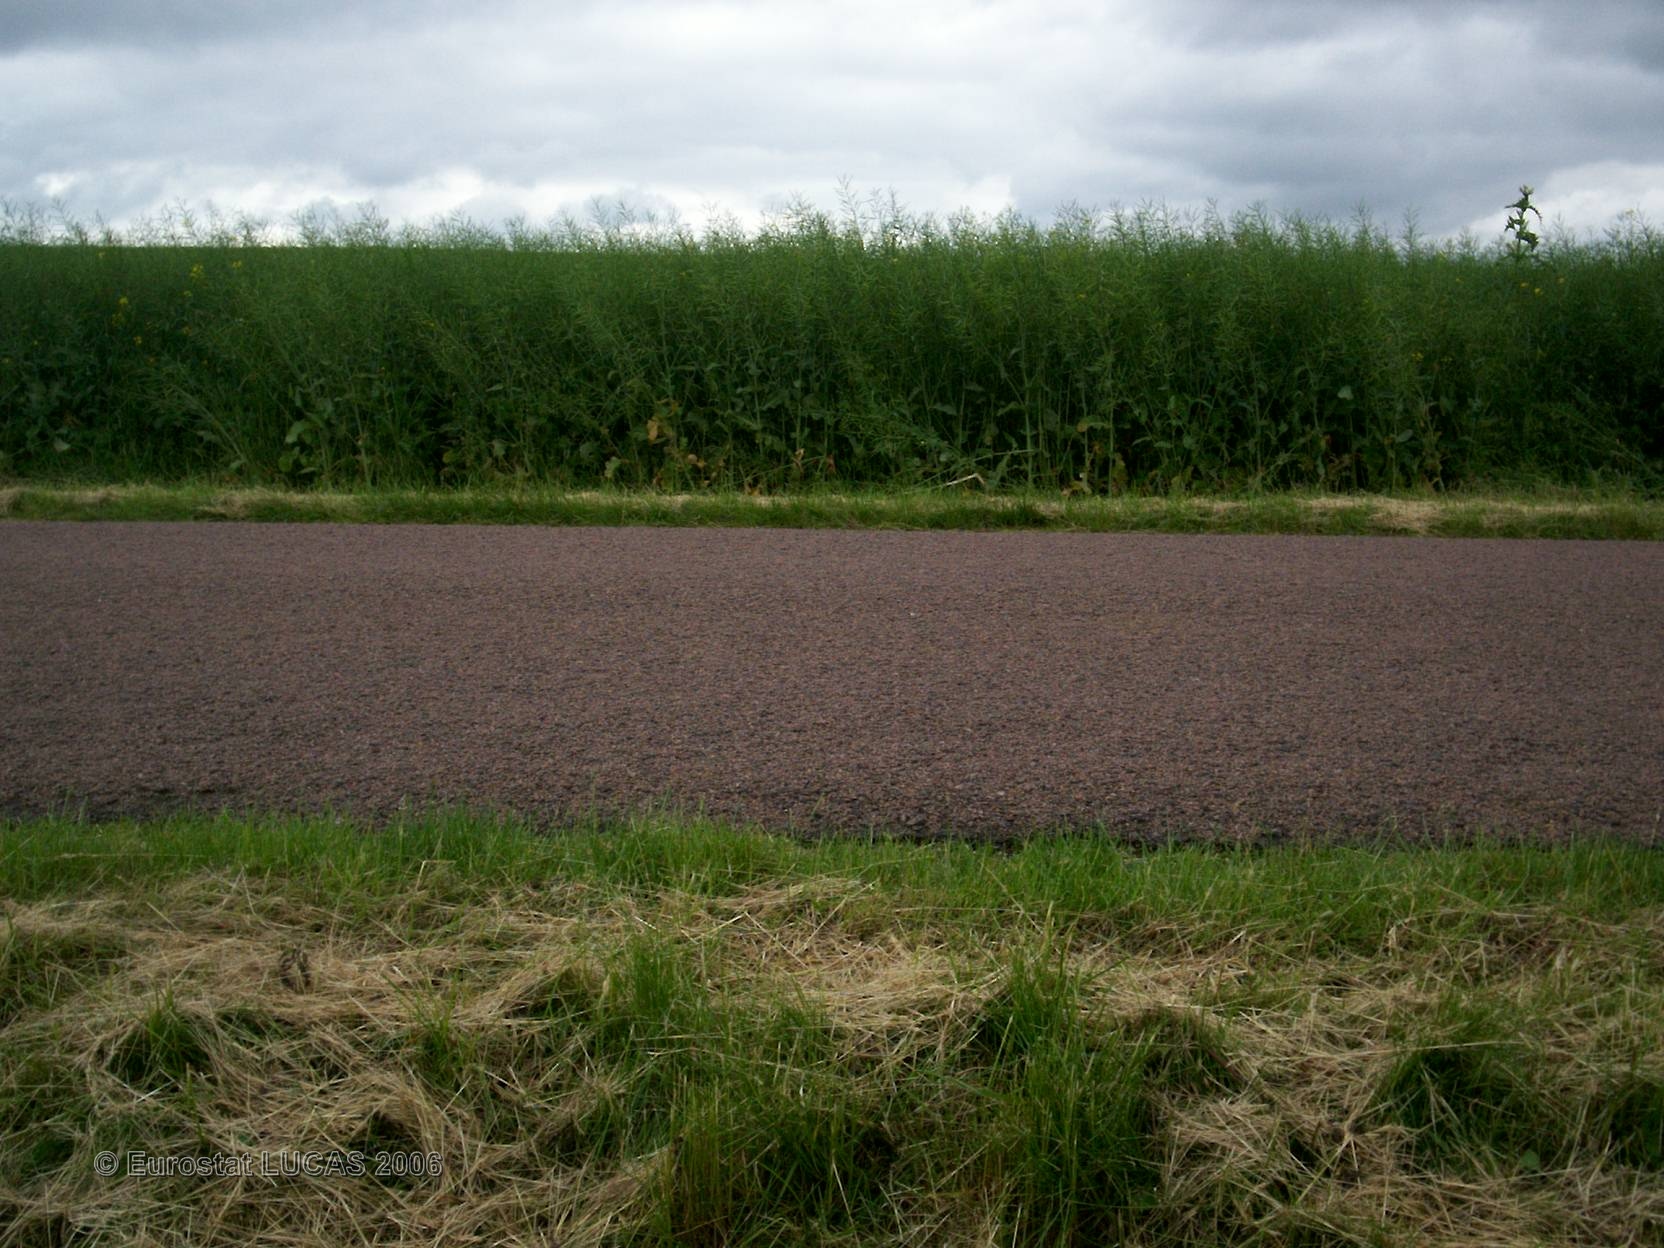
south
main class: Cropland
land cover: Rape and turnip rape
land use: Agriculture (excluding fallow land and kitchen gardens)
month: May
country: FR
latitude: 48.1969
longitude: 4.5491
